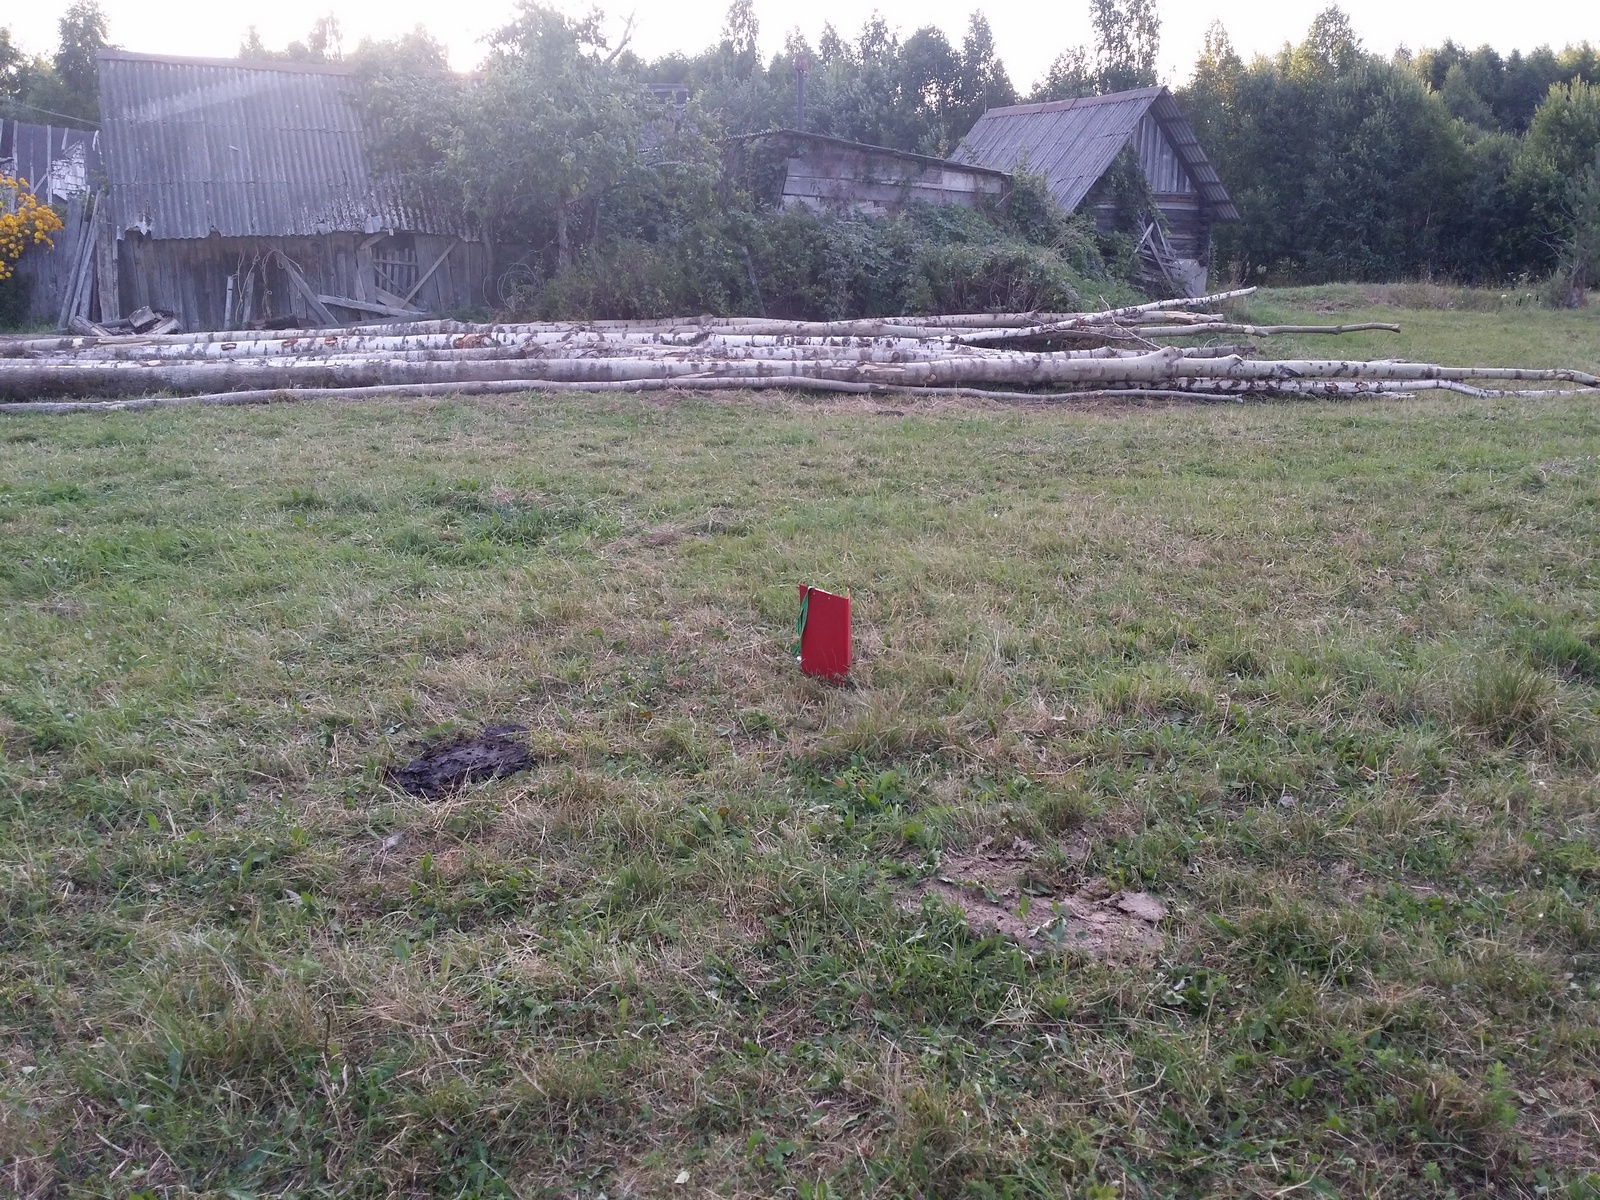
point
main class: Grassland
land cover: Grassland without tree/shrub cover
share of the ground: > 75 %
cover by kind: herbaceous plants 90 %, unconsolidated bare surface 10 %
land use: Agriculture (excluding fallow land and kitchen gardens)
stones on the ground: < 10 %
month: August
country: LV
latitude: 57.1946
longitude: 27.7083
